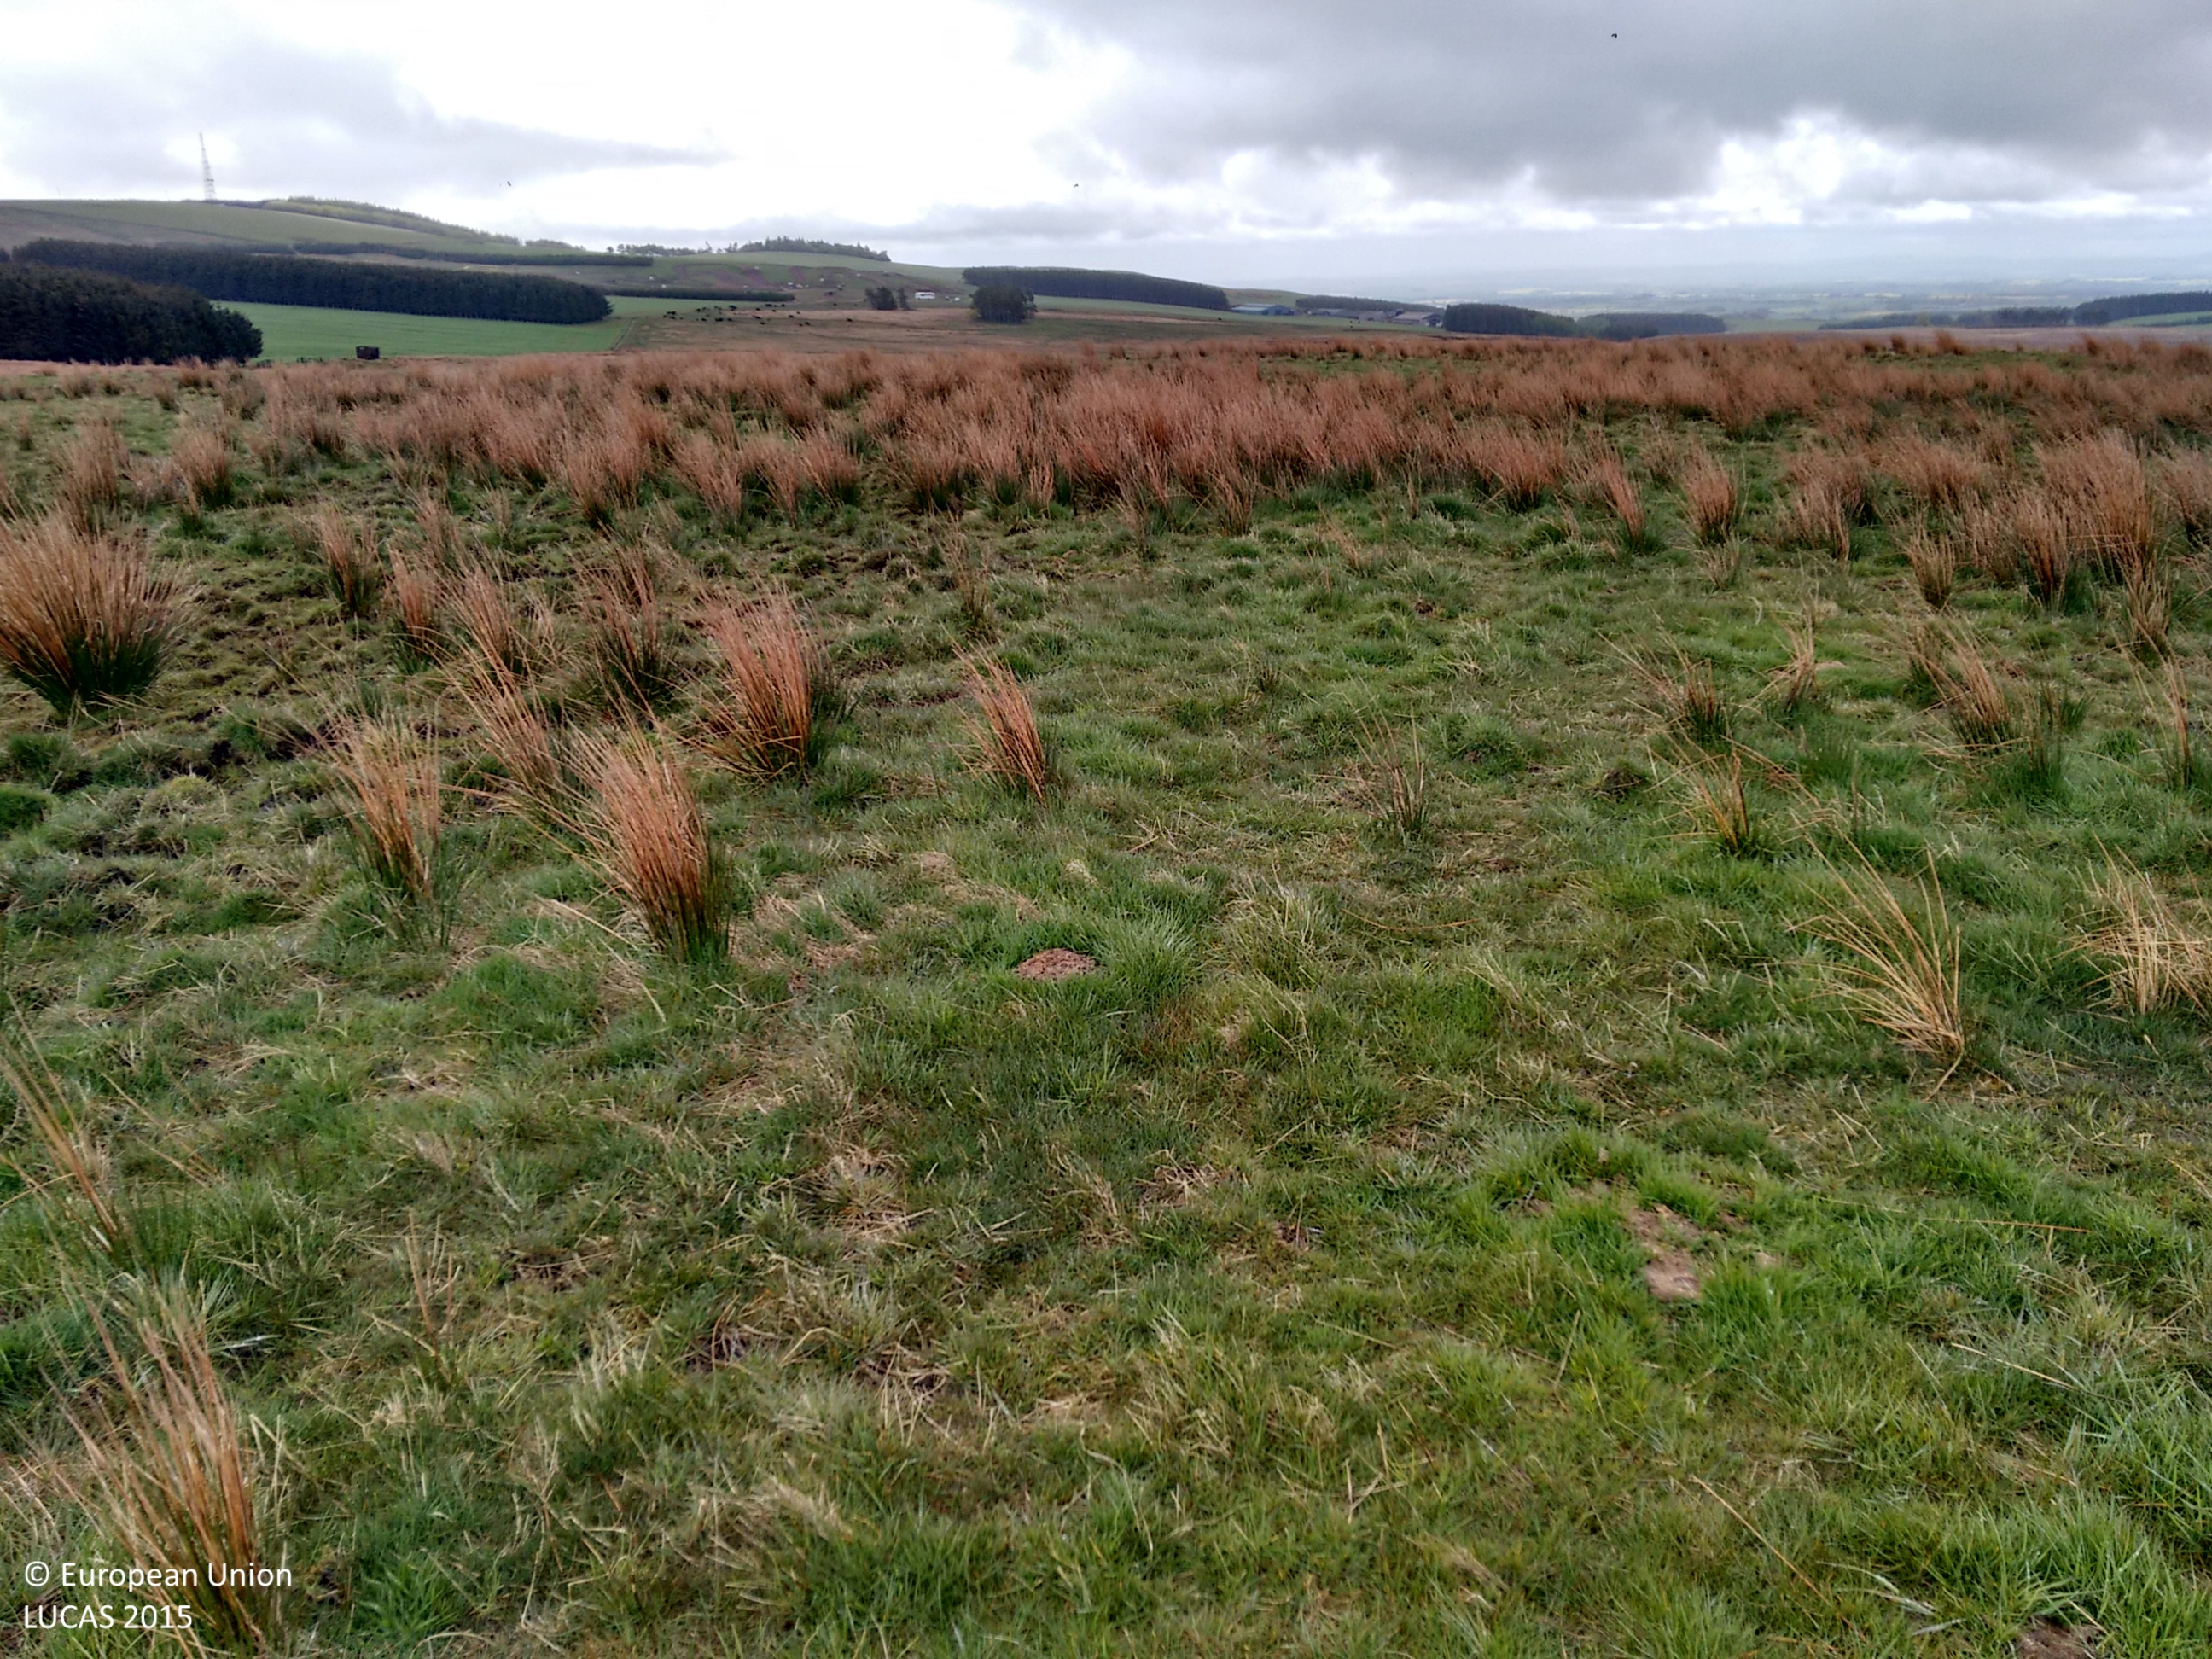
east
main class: Grassland
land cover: Grassland without tree/shrub cover
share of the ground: > 75 %
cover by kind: herbaceous plants 100 %
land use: Agriculture (excluding fallow land and kitchen gardens)
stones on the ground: < 10 %
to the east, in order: Grassland without tree/shrub cover
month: May
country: GB
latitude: 55.7791
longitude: -2.4475
